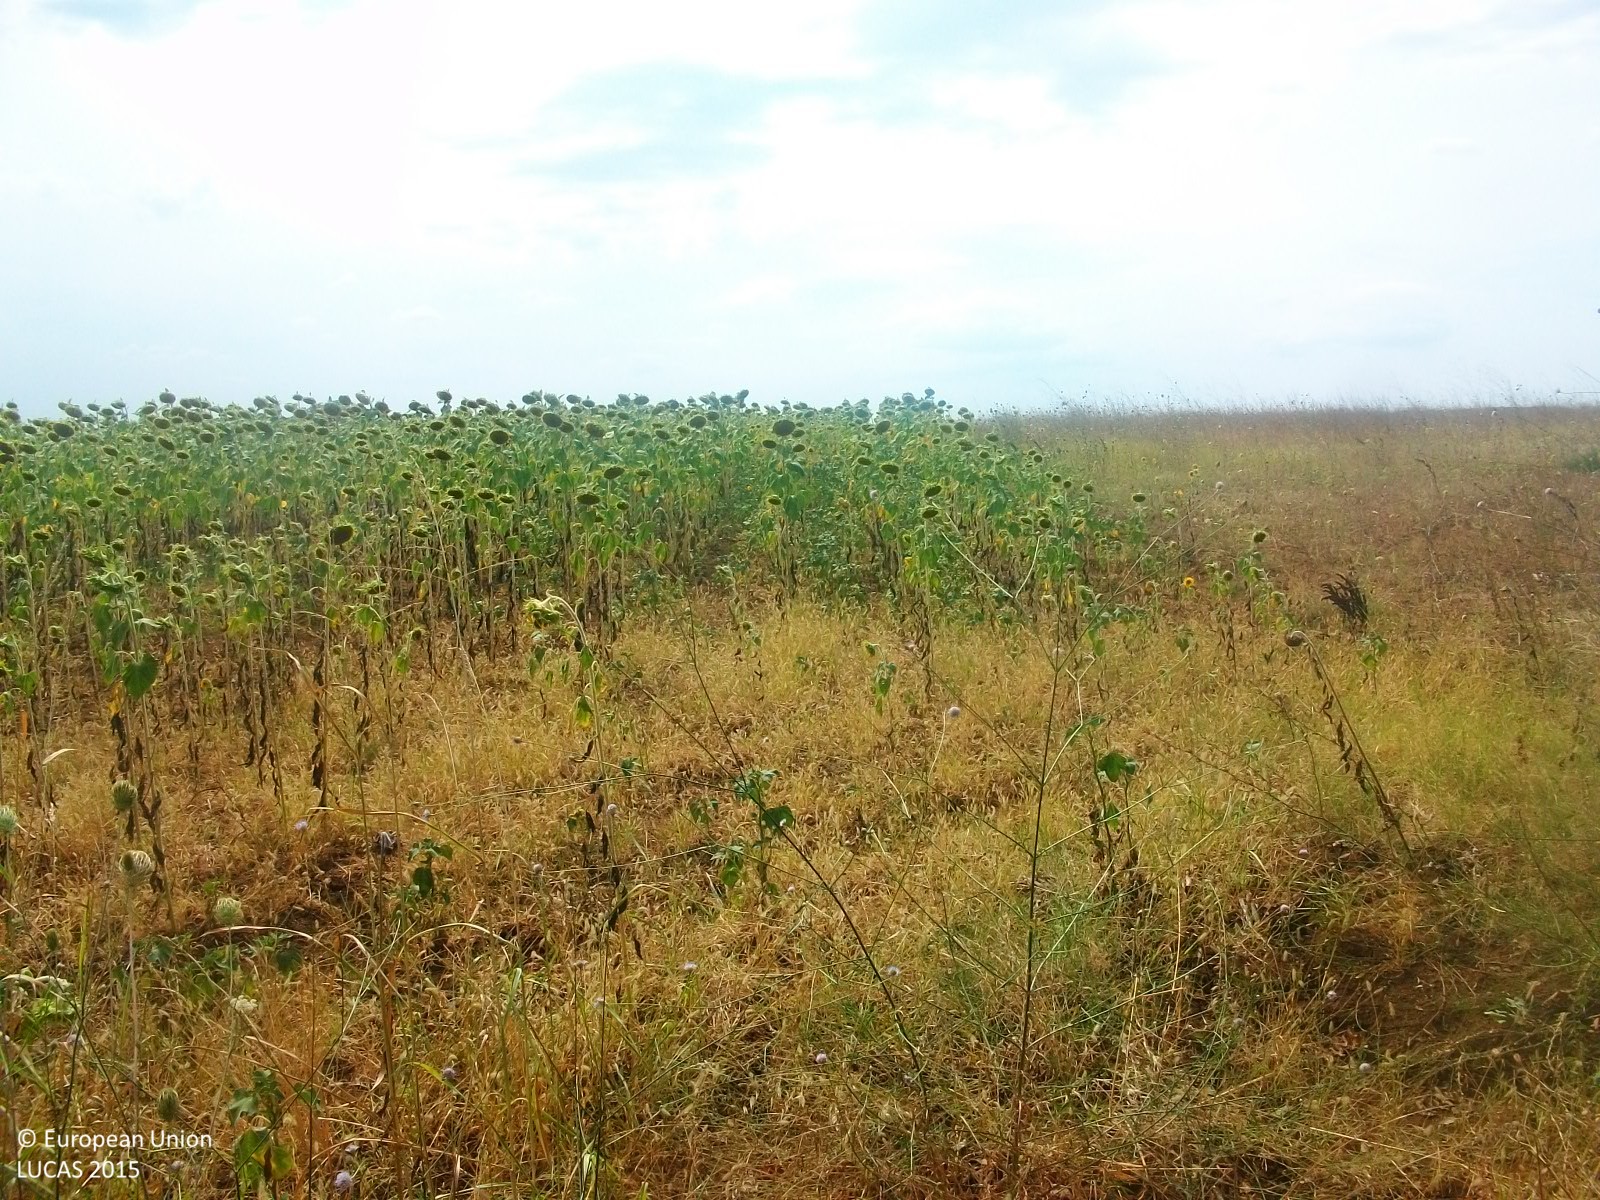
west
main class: Woodland
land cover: Broadleaved woodland
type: thermophilous deciduous forest
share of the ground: > 75 %
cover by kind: broadleaved forest trees 90 %, shrubs 10 %
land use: Semi-natural and natural areas not in use
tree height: > 5 m
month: August
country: GR
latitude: 41.3022
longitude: 26.2047
